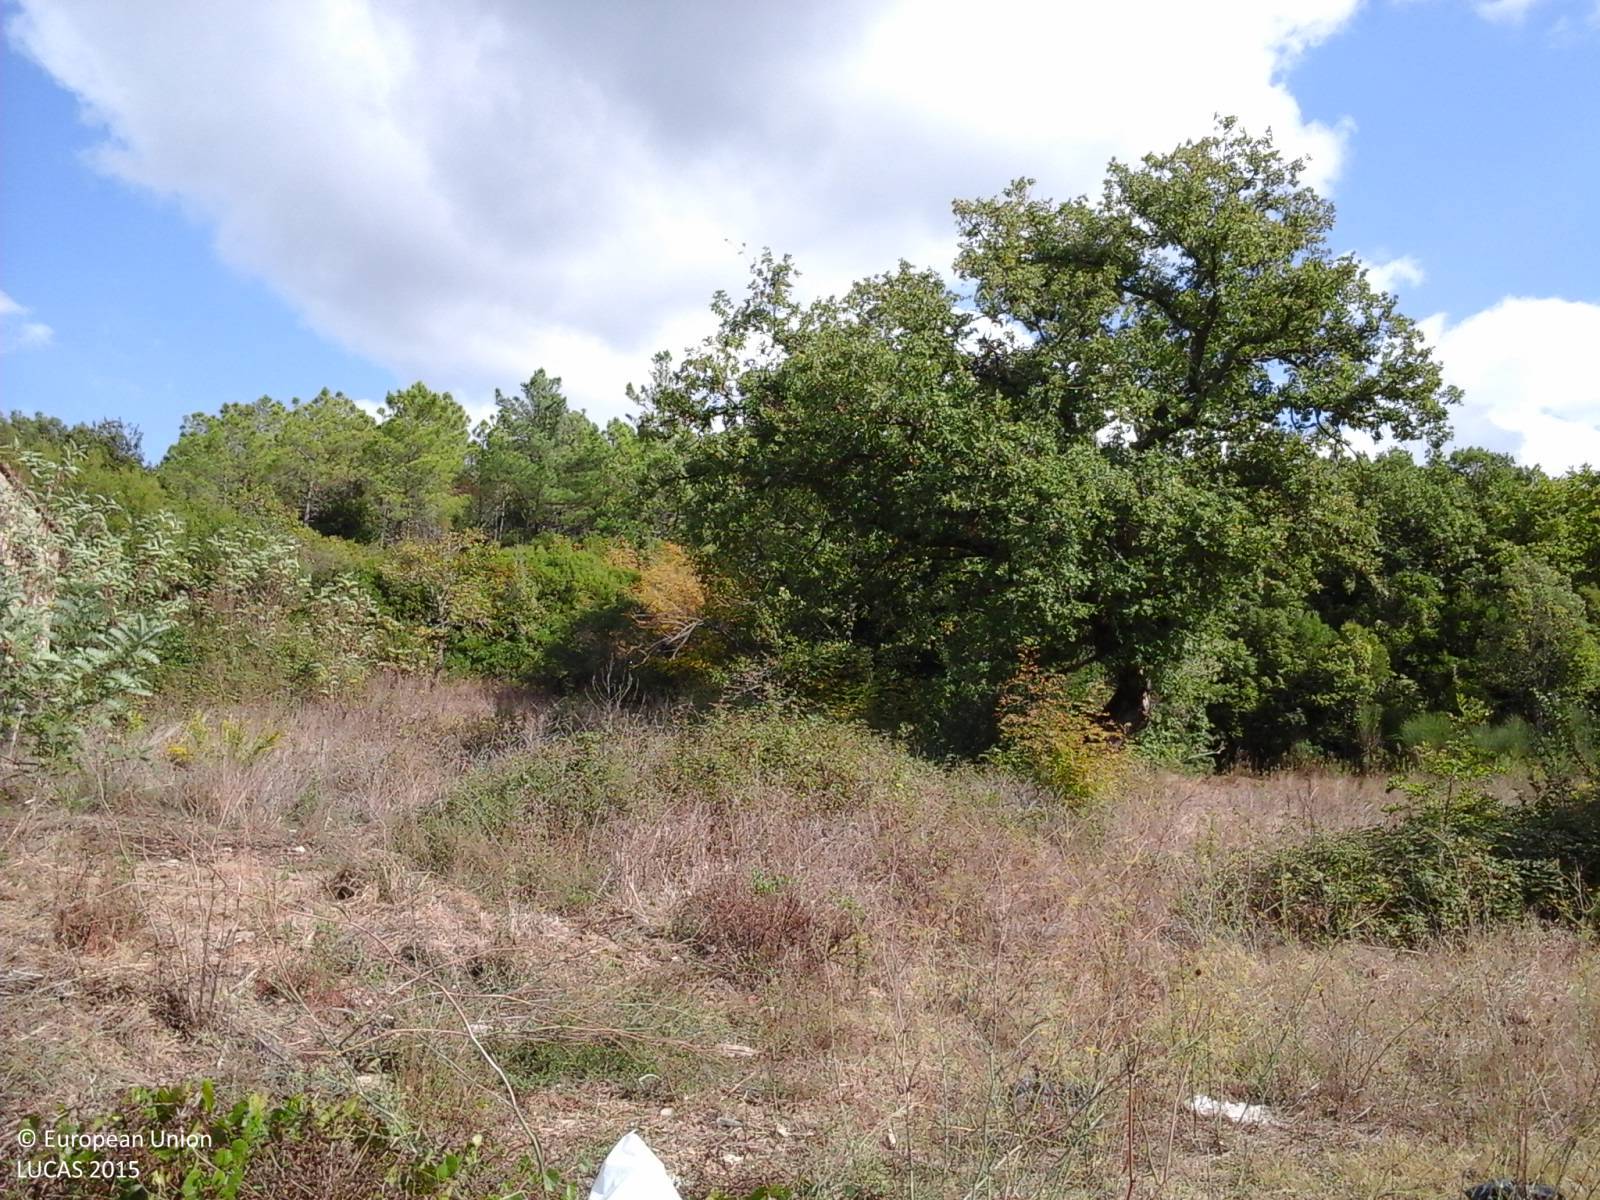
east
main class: Woodland
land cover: Pine dominated coniferous woodland
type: coniferous forest of the mediterranean region
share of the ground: > 75 %
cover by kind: coniferous forest trees 90 %, broadleaved forest trees 10 %
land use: Forestry
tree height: > 5 m
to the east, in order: Pine dominated coniferous woodland; Broadleaved woodland
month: October
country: IT
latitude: 43.0666
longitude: 10.7468
